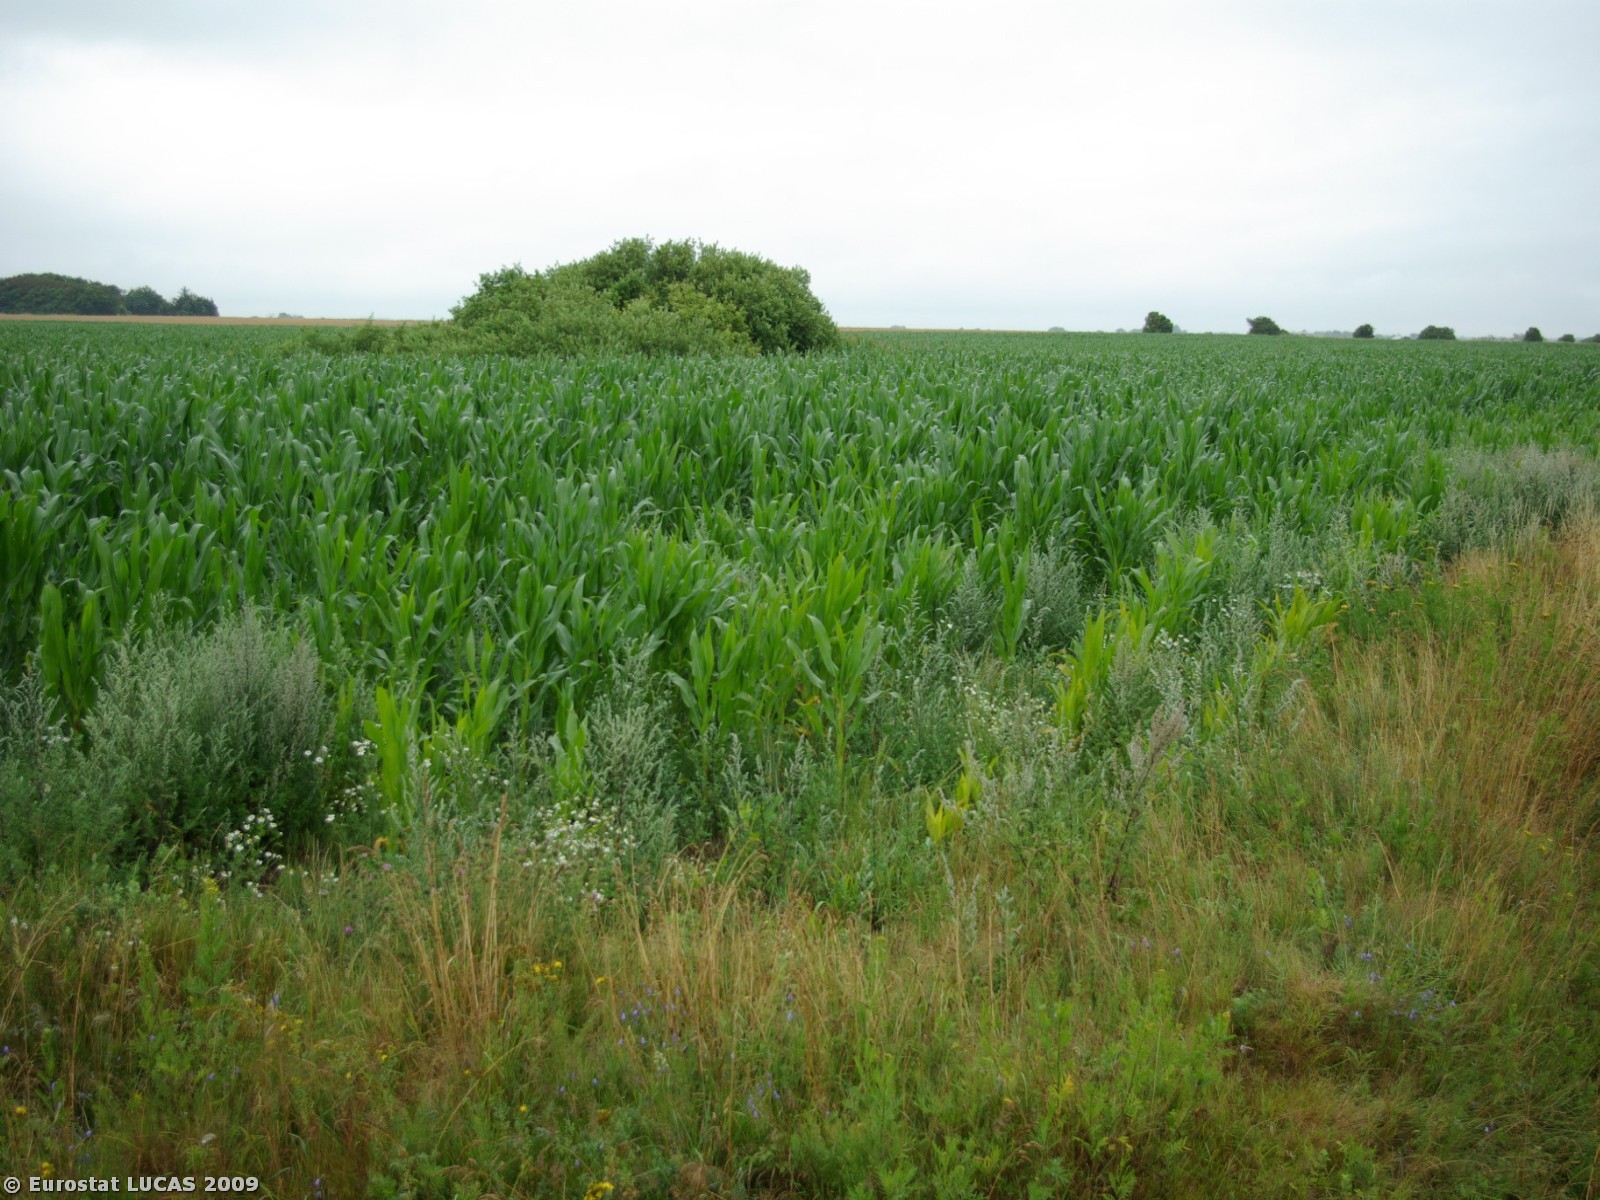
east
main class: Cropland
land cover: Maize
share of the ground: > 75 %
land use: Agriculture (excluding fallow land and kitchen gardens)
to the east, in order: Maize; Grass margins; Ditches and canals; Grass margins; Maize; Spontaneously vegetated surfaces; Ditches and canals; Spontaneously vegetated surfaces; Common wheat
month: July
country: DK
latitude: 55.0843
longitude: 8.6694
